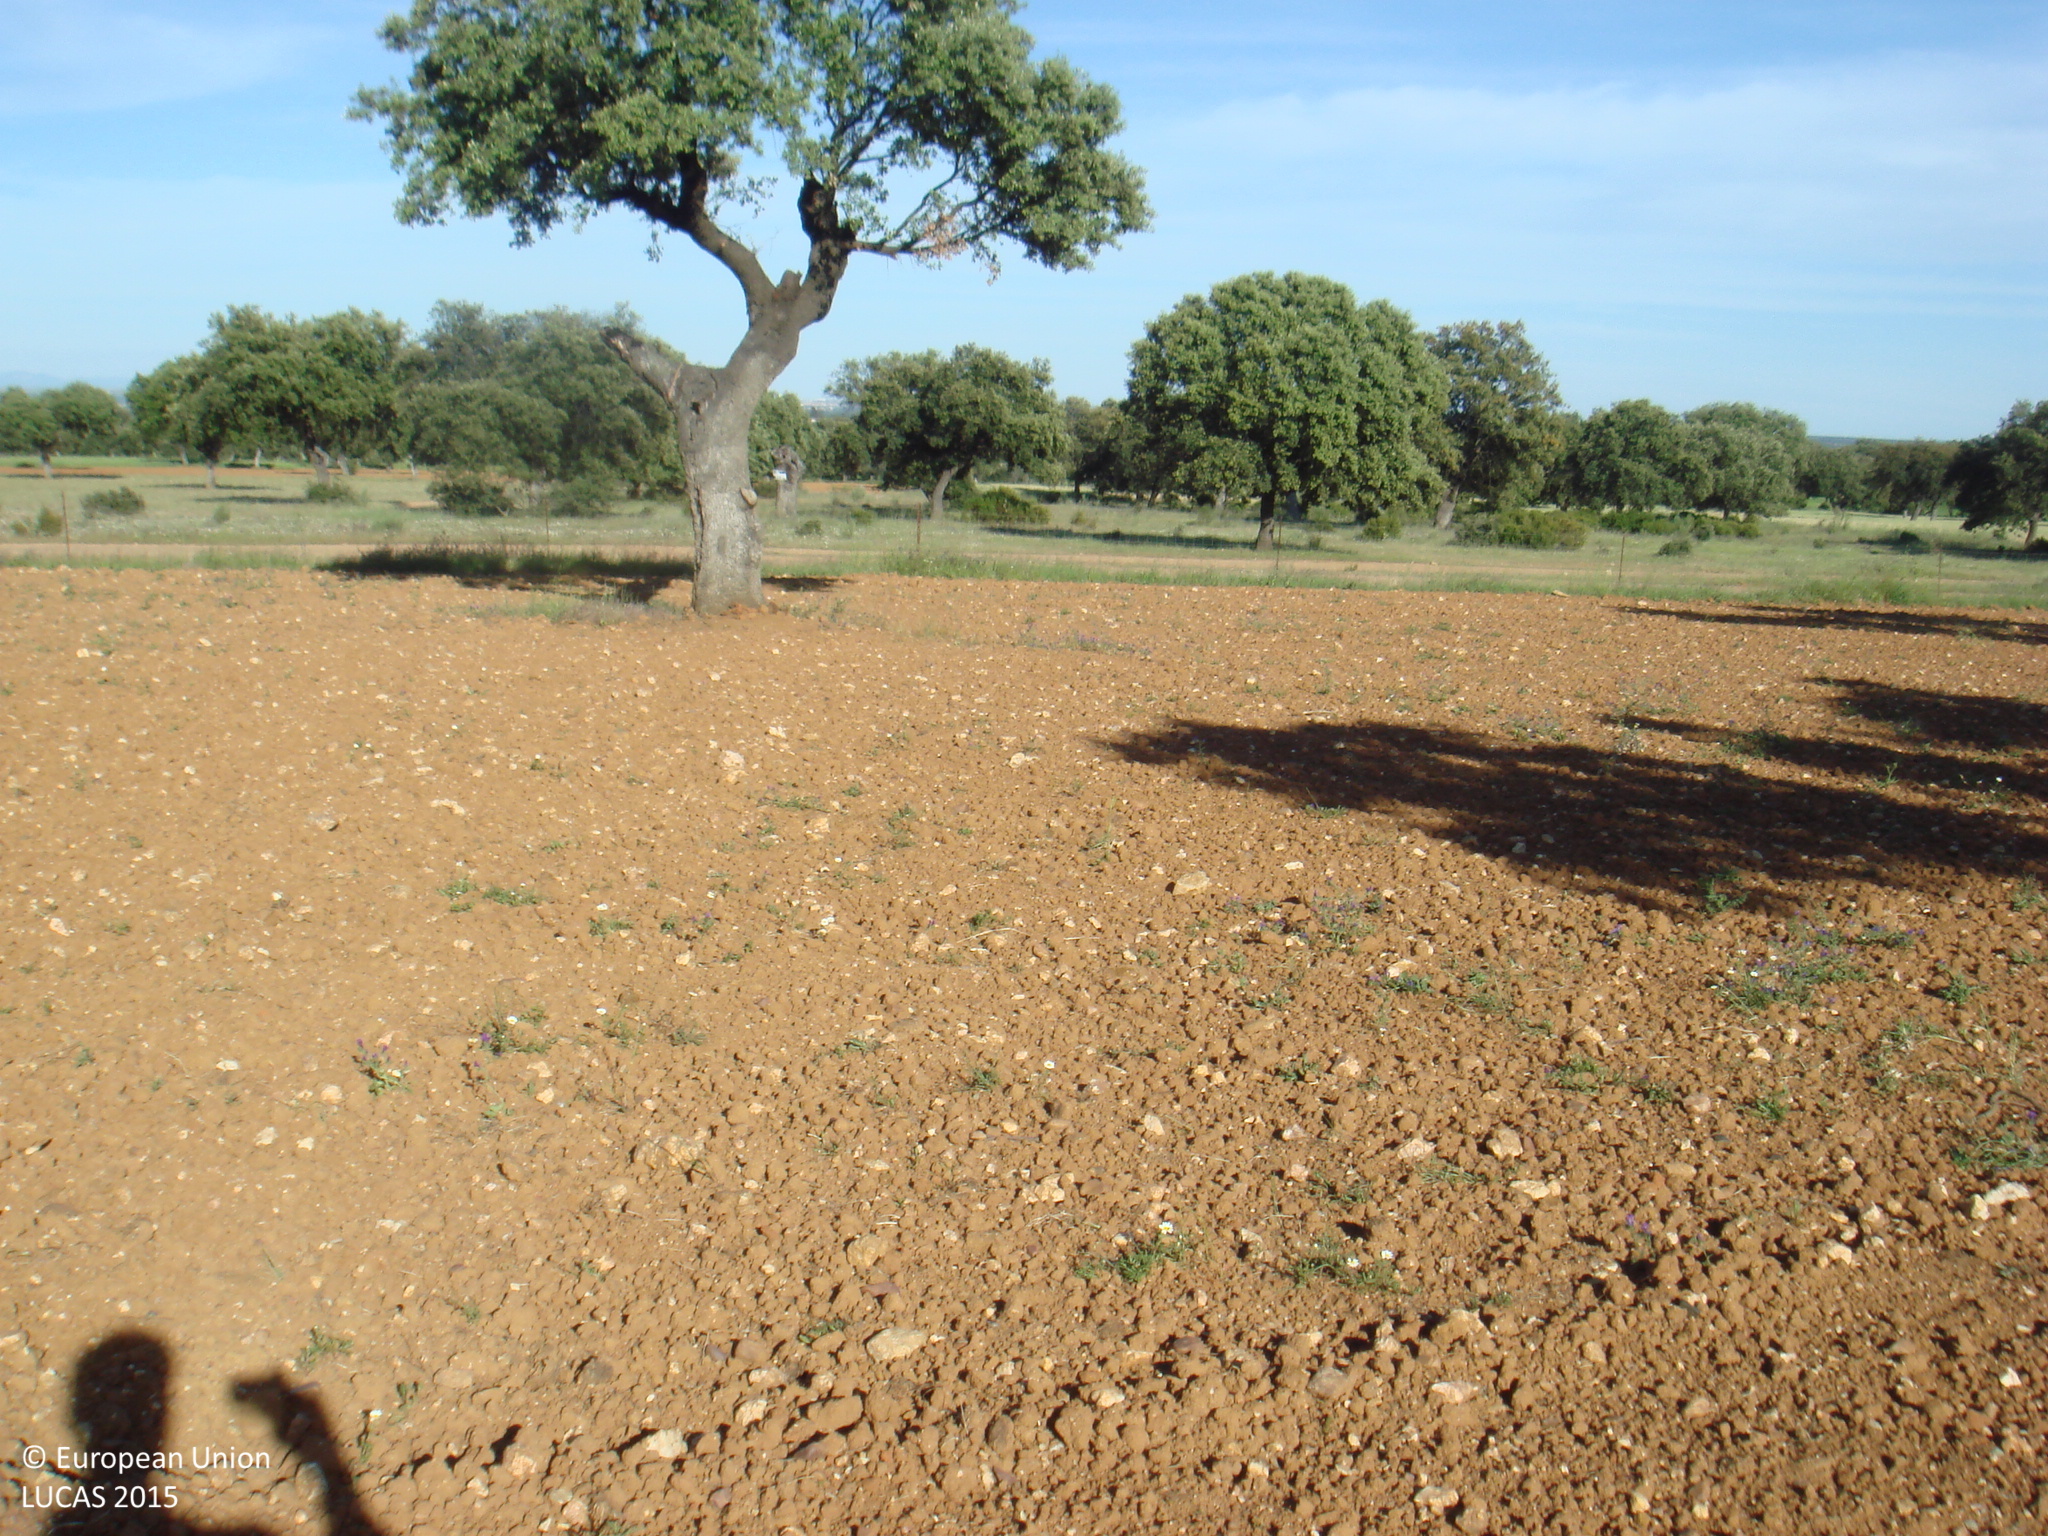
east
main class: Woodland
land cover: Broadleaved woodland
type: broadleaved evergreen forest
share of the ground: 10 - 25 %
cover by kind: unconsolidated bare surface 75 %, broadleaved forest trees 20 %, herbaceous plants 5 %
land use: Agriculture (excluding fallow land and kitchen gardens)
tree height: > 5 m
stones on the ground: 25 - 50 %
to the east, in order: Broadleaved woodland; Grass margins; Fences; Tracks; Grassland with sparse tree/shrub cover; Tracks; Broadleaved woodland; Grassland with sparse tree/shrub cover; Tracks; Grassland with sparse tree/shrub cover
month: April
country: ES
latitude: 38.4236
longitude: -5.1366
